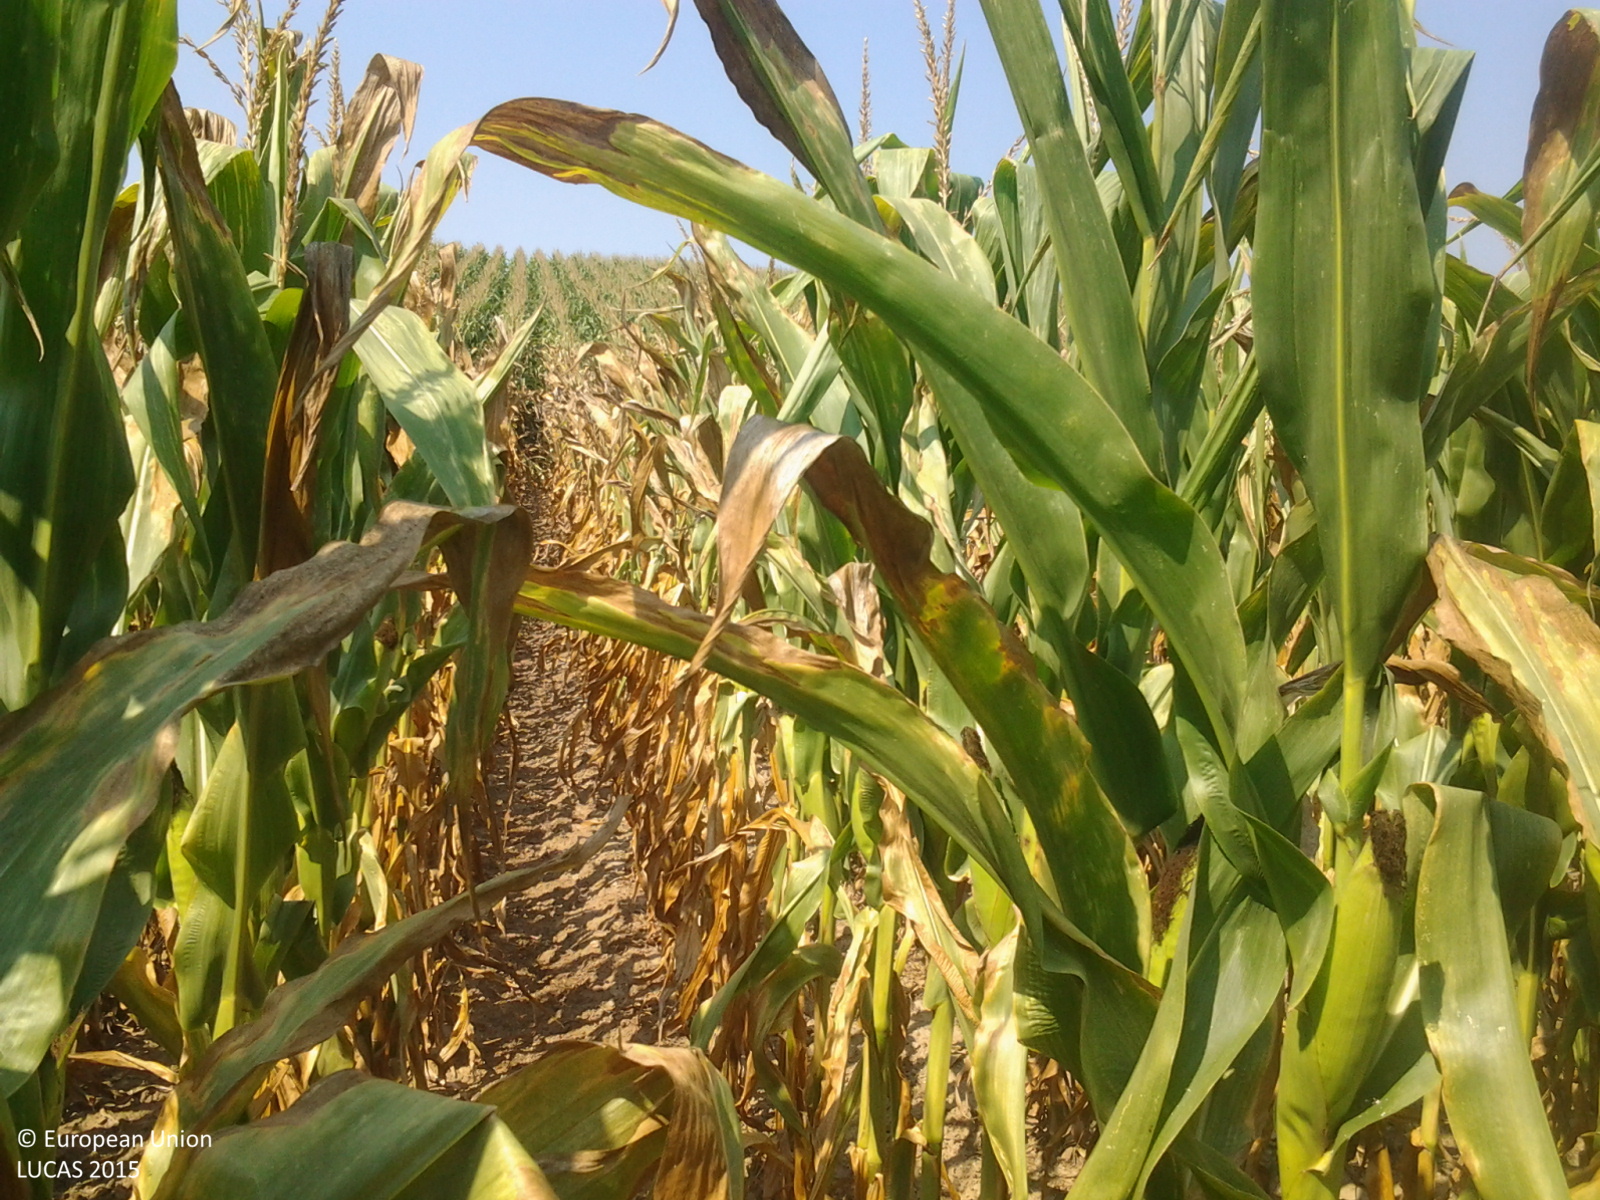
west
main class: Cropland
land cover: Maize
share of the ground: > 75 %
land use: Agriculture (excluding fallow land and kitchen gardens)
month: August
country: HU
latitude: 46.6172
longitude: 18.4067
